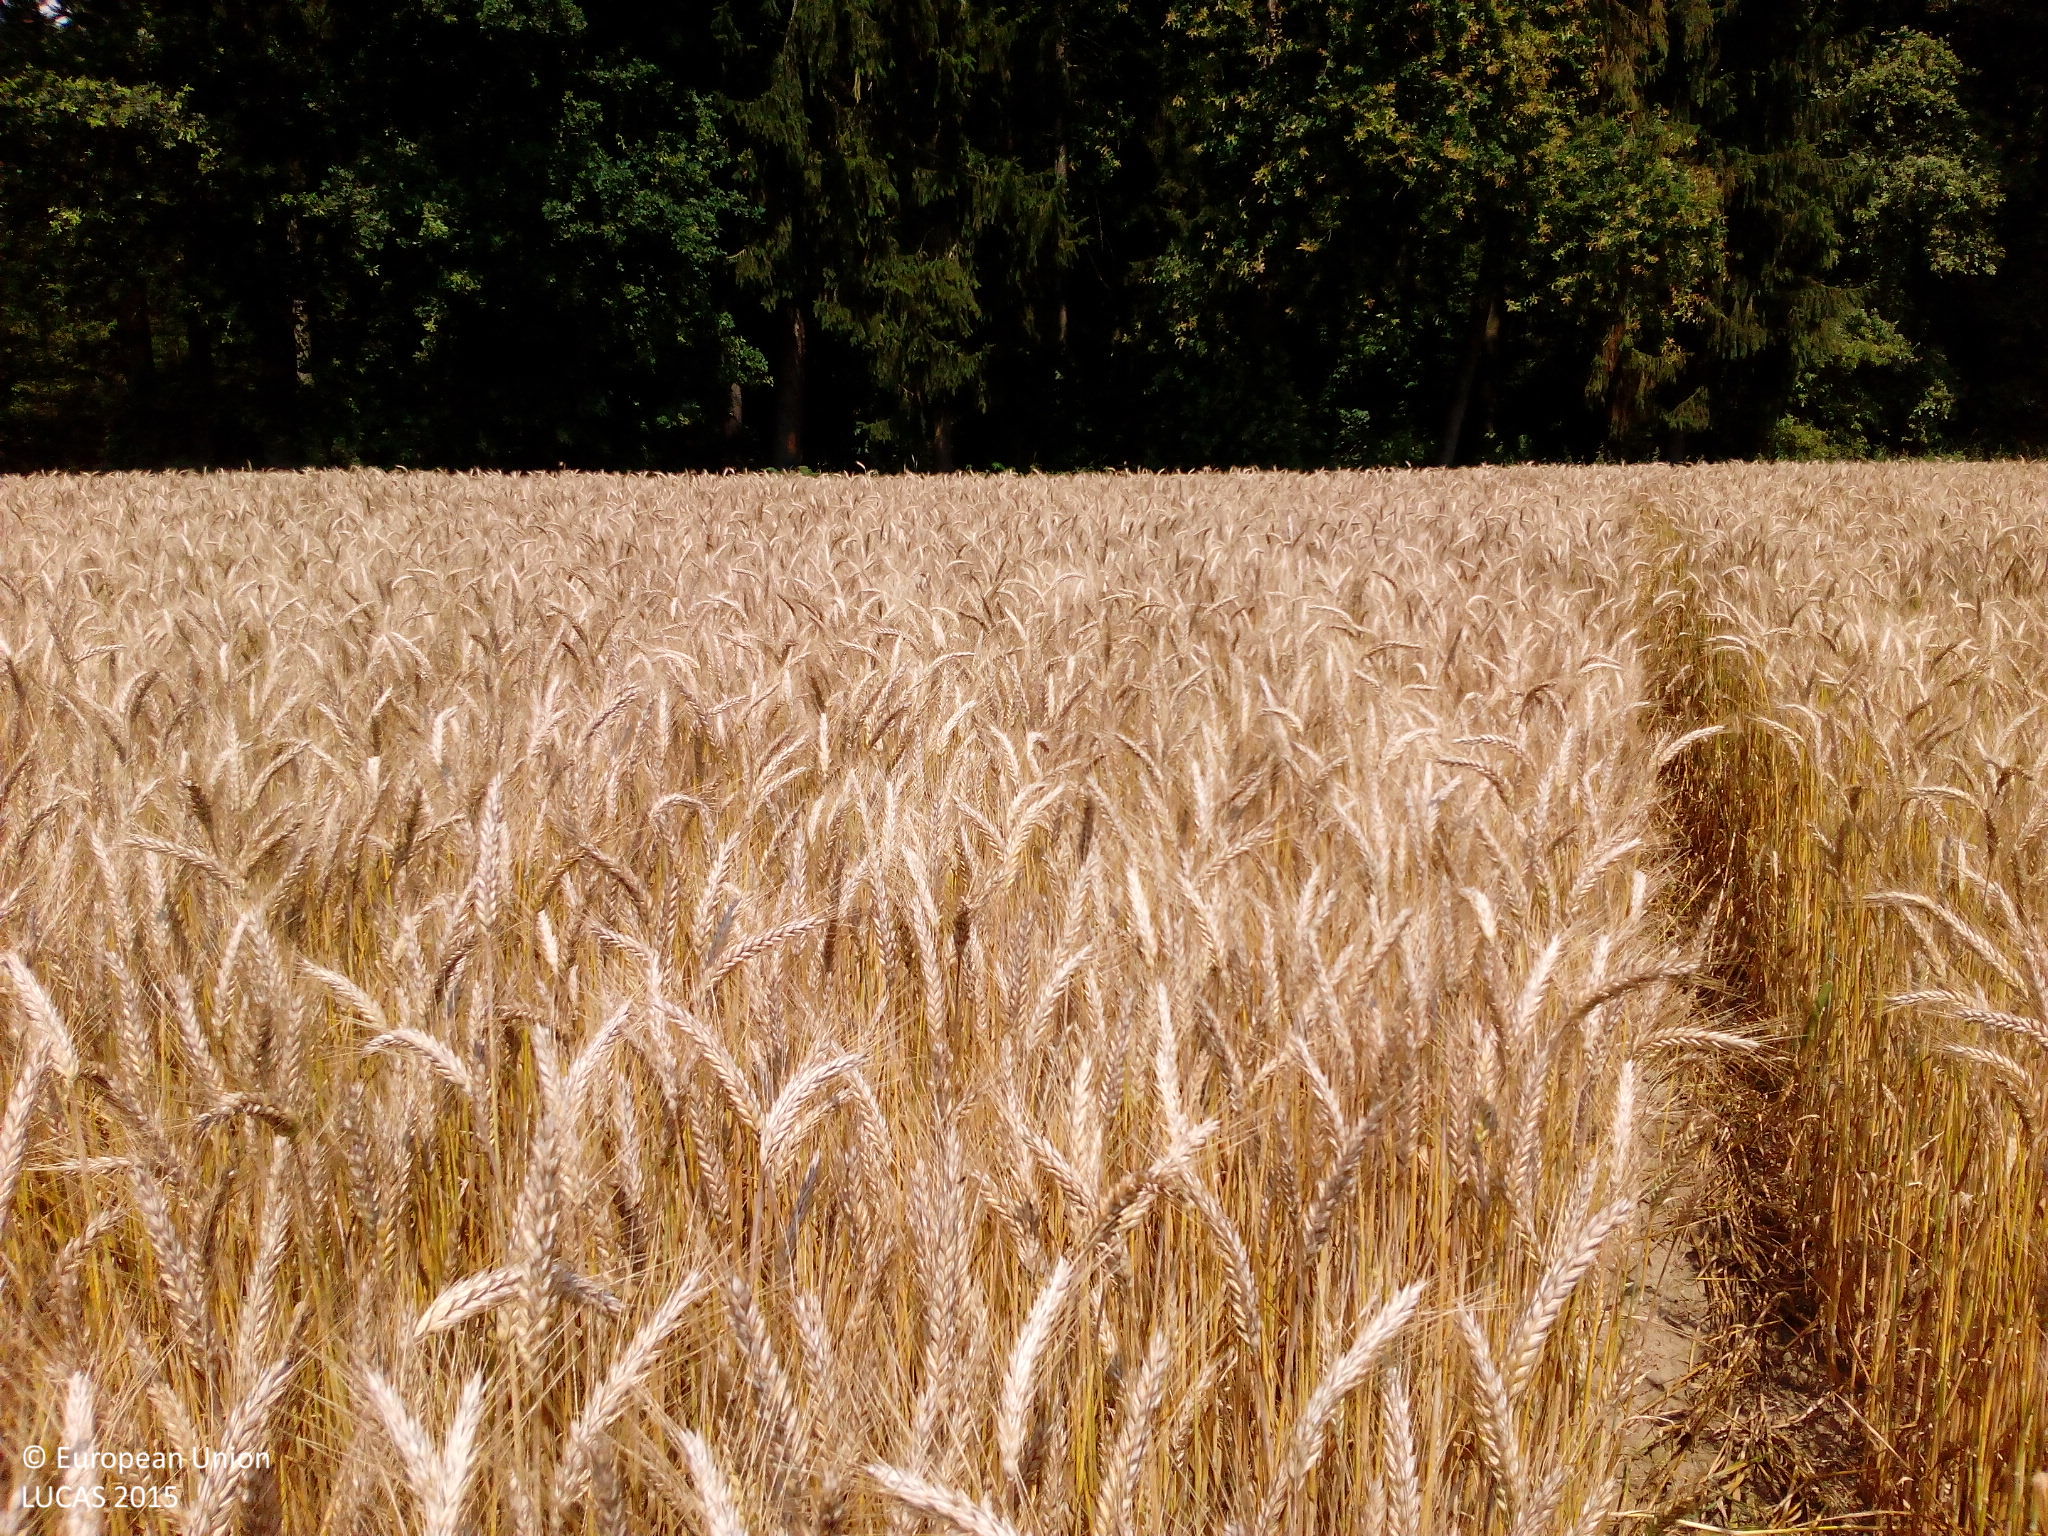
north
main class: Cropland
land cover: Rye
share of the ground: > 75 %
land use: Agriculture (excluding fallow land and kitchen gardens)
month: July
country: DE
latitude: 48.8008
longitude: 11.9190
